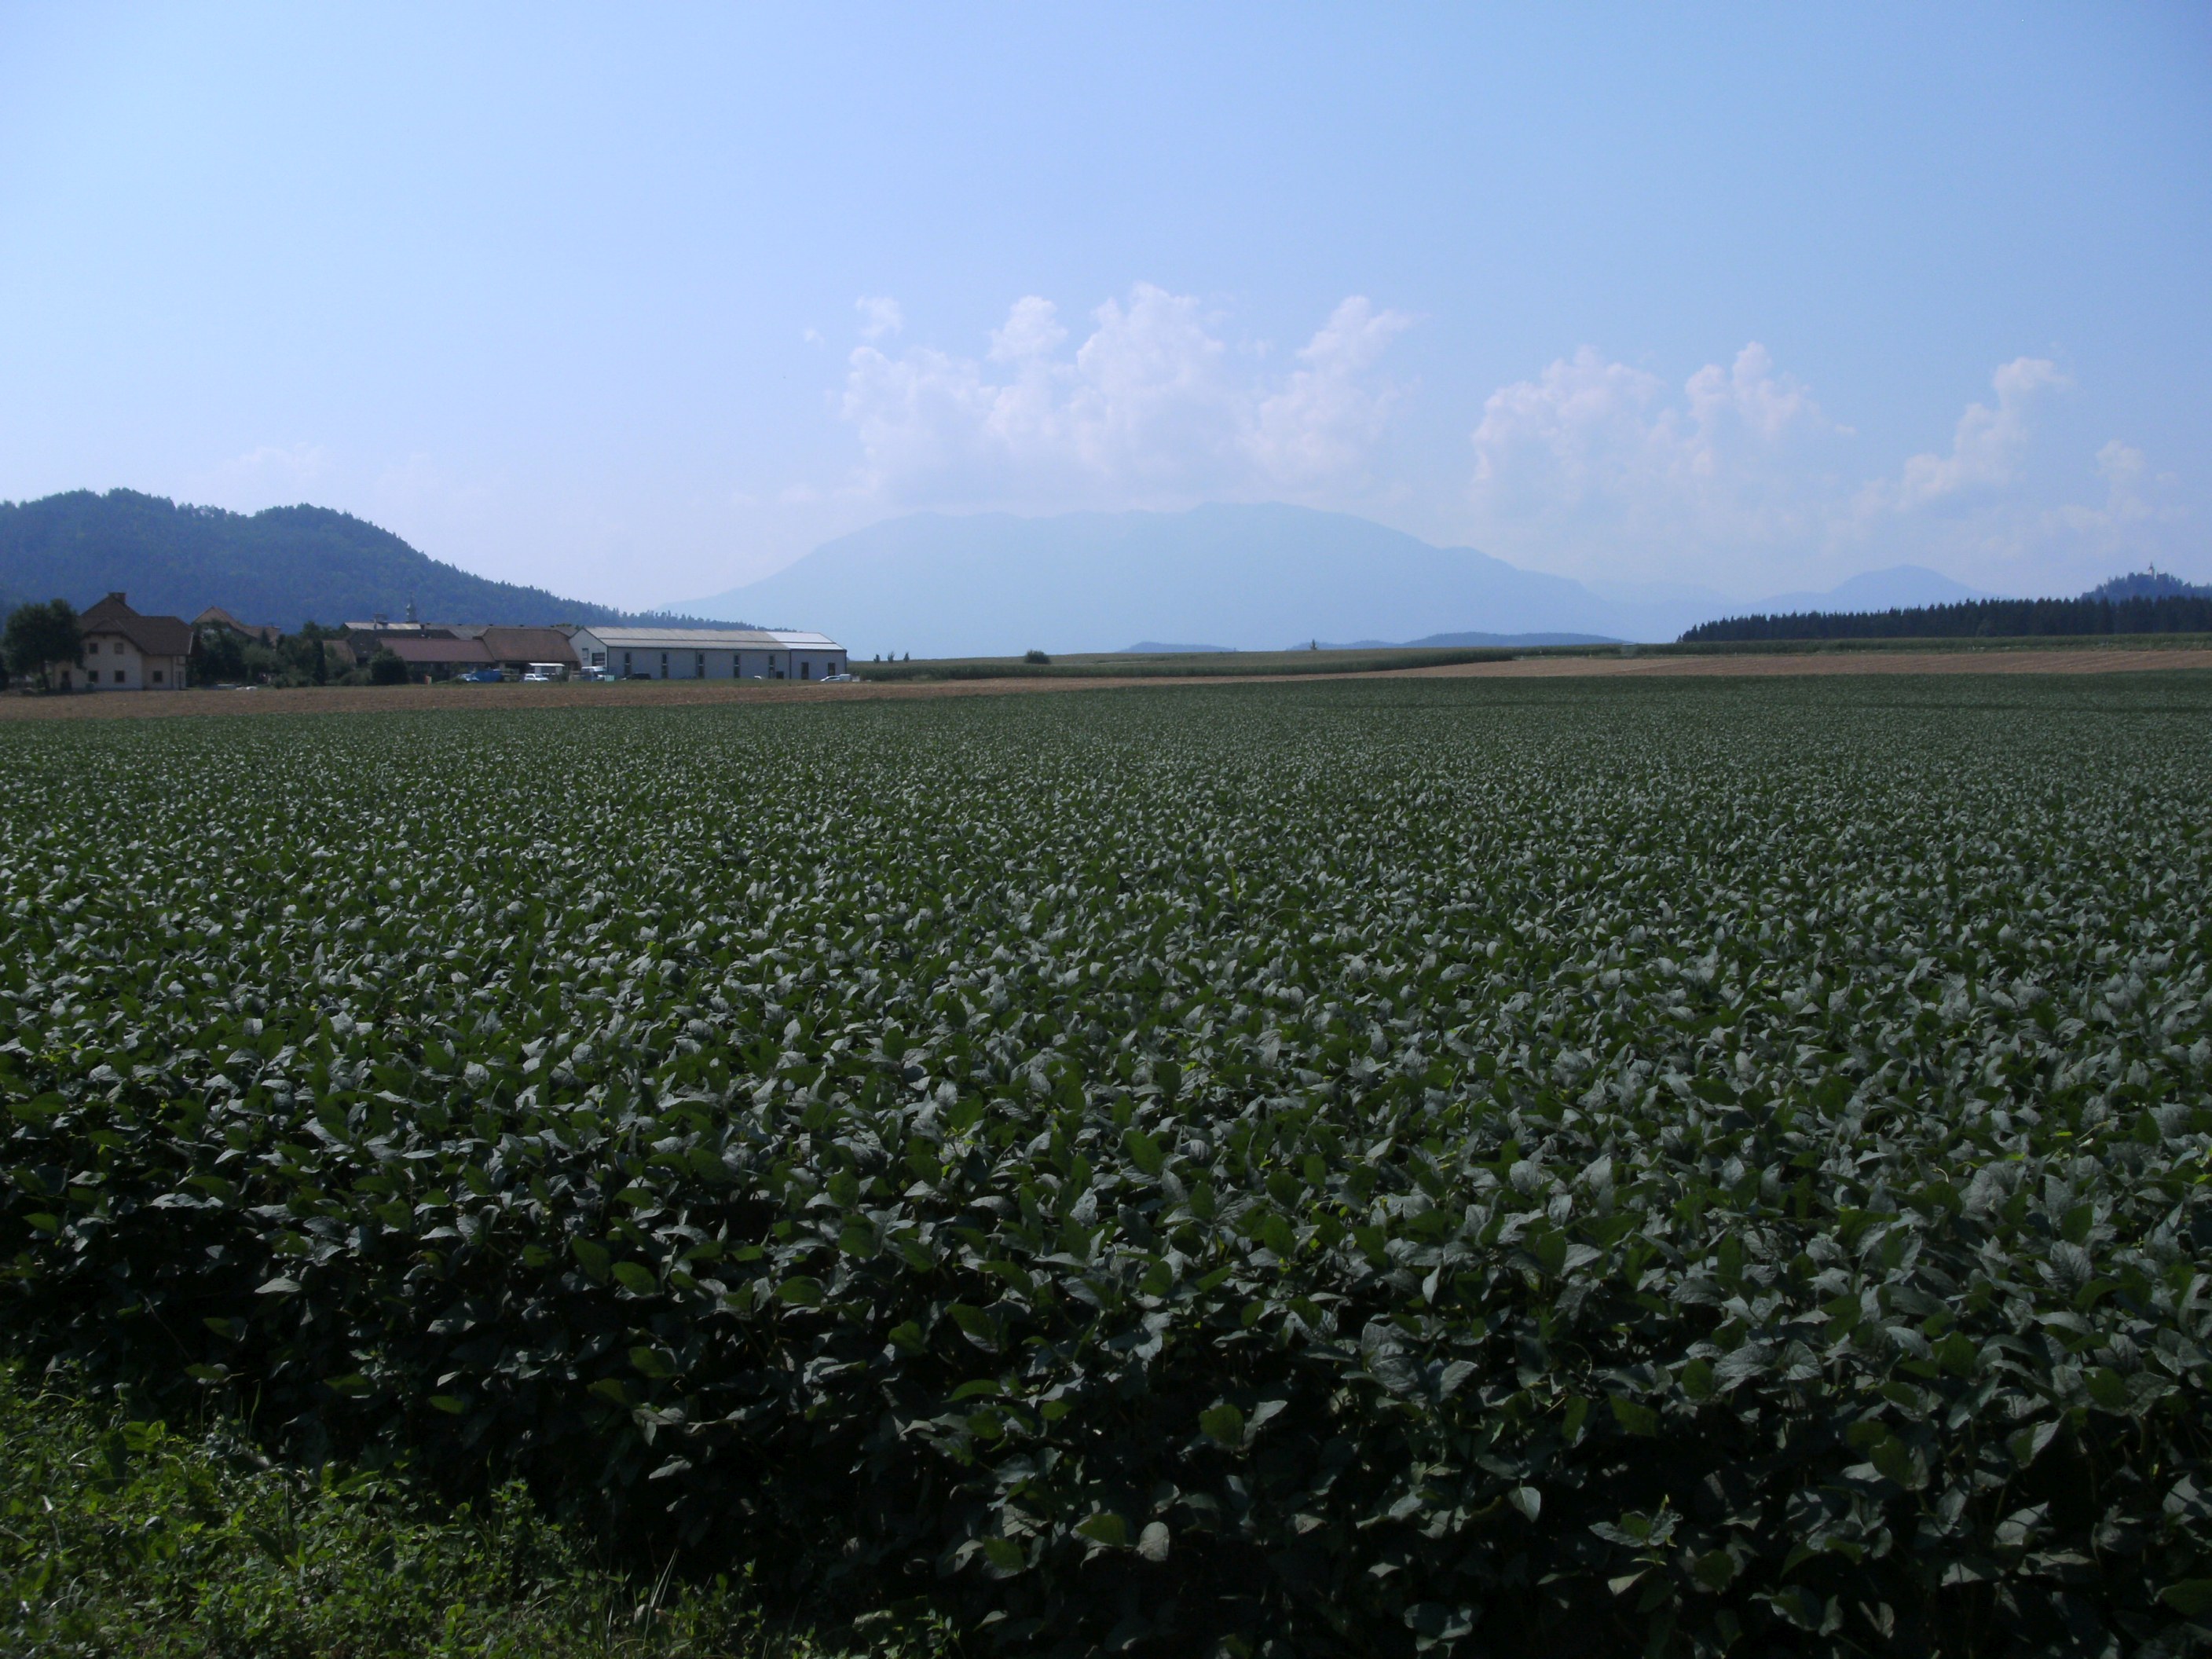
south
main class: Cropland
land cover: Temporary grasslands
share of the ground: > 75 %
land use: Agriculture (excluding fallow land and kitchen gardens)
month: July
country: AT
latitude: 46.6778
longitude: 14.7696
